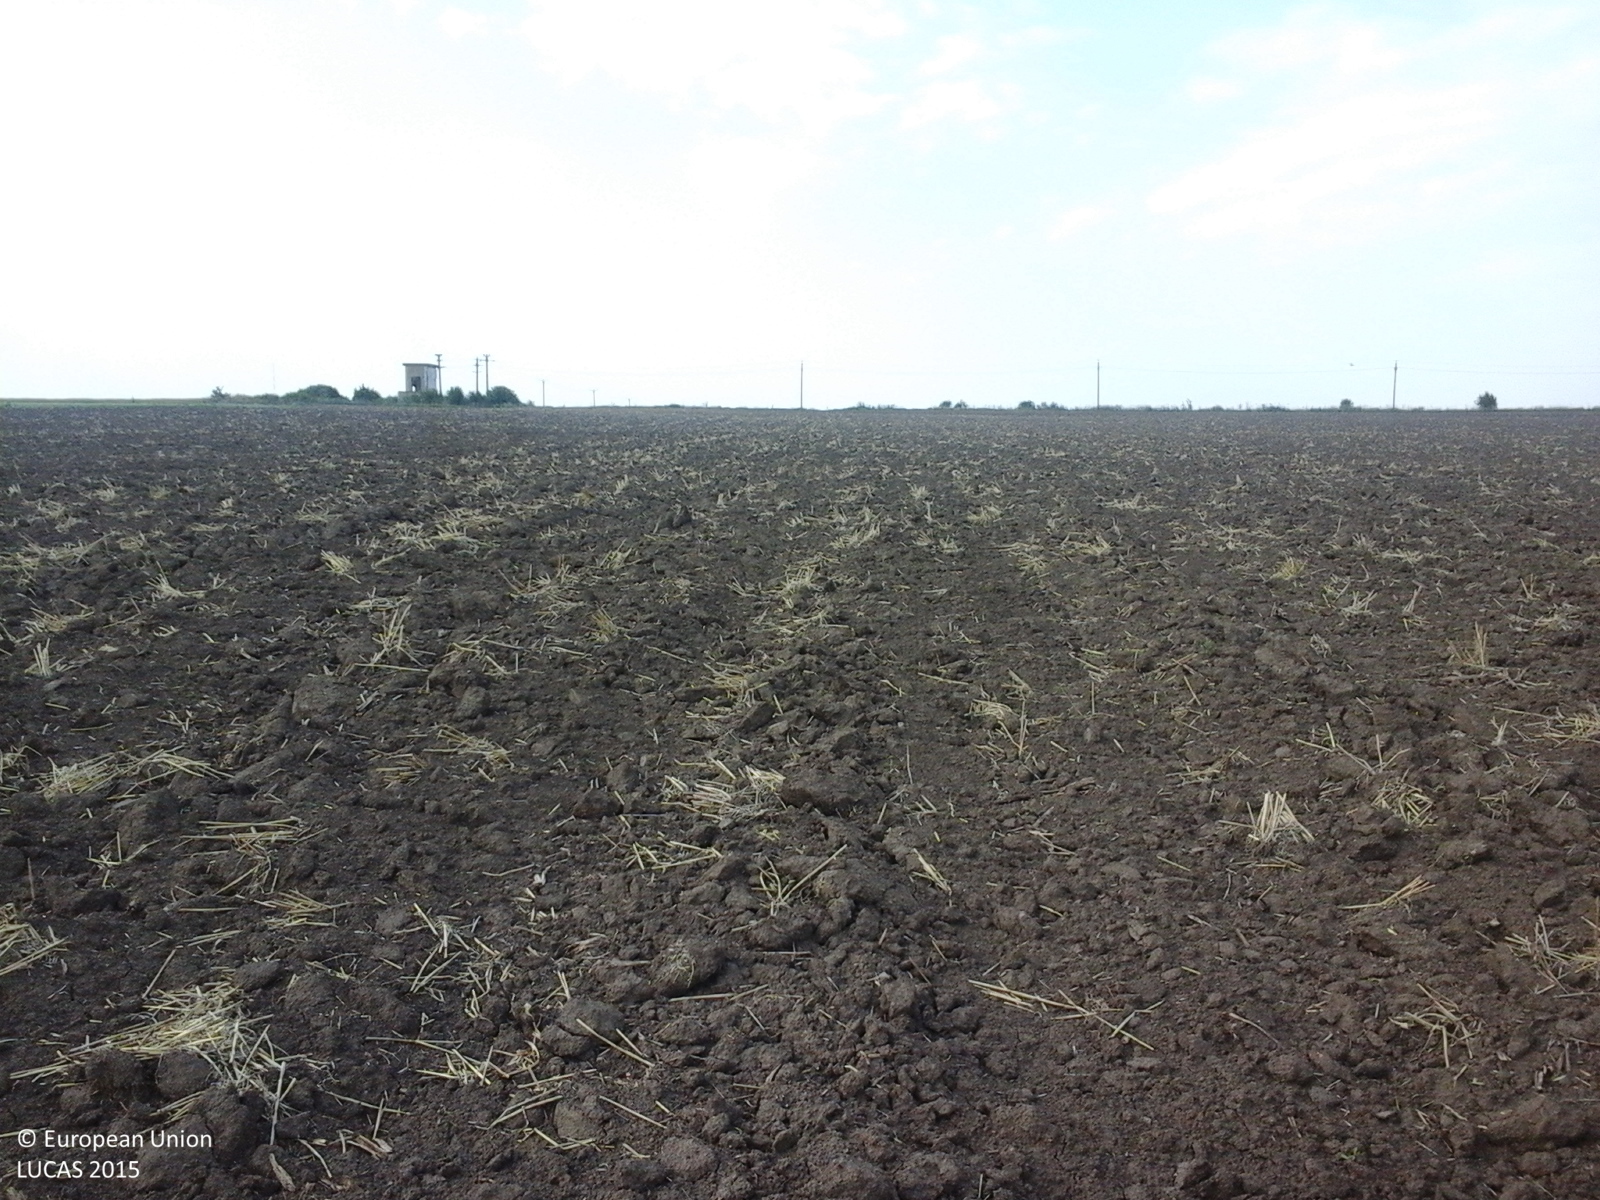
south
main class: Cropland
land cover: Common wheat
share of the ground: < 10 %
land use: Agriculture (excluding fallow land and kitchen gardens)
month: August
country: RO
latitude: 43.8053
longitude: 28.1404
